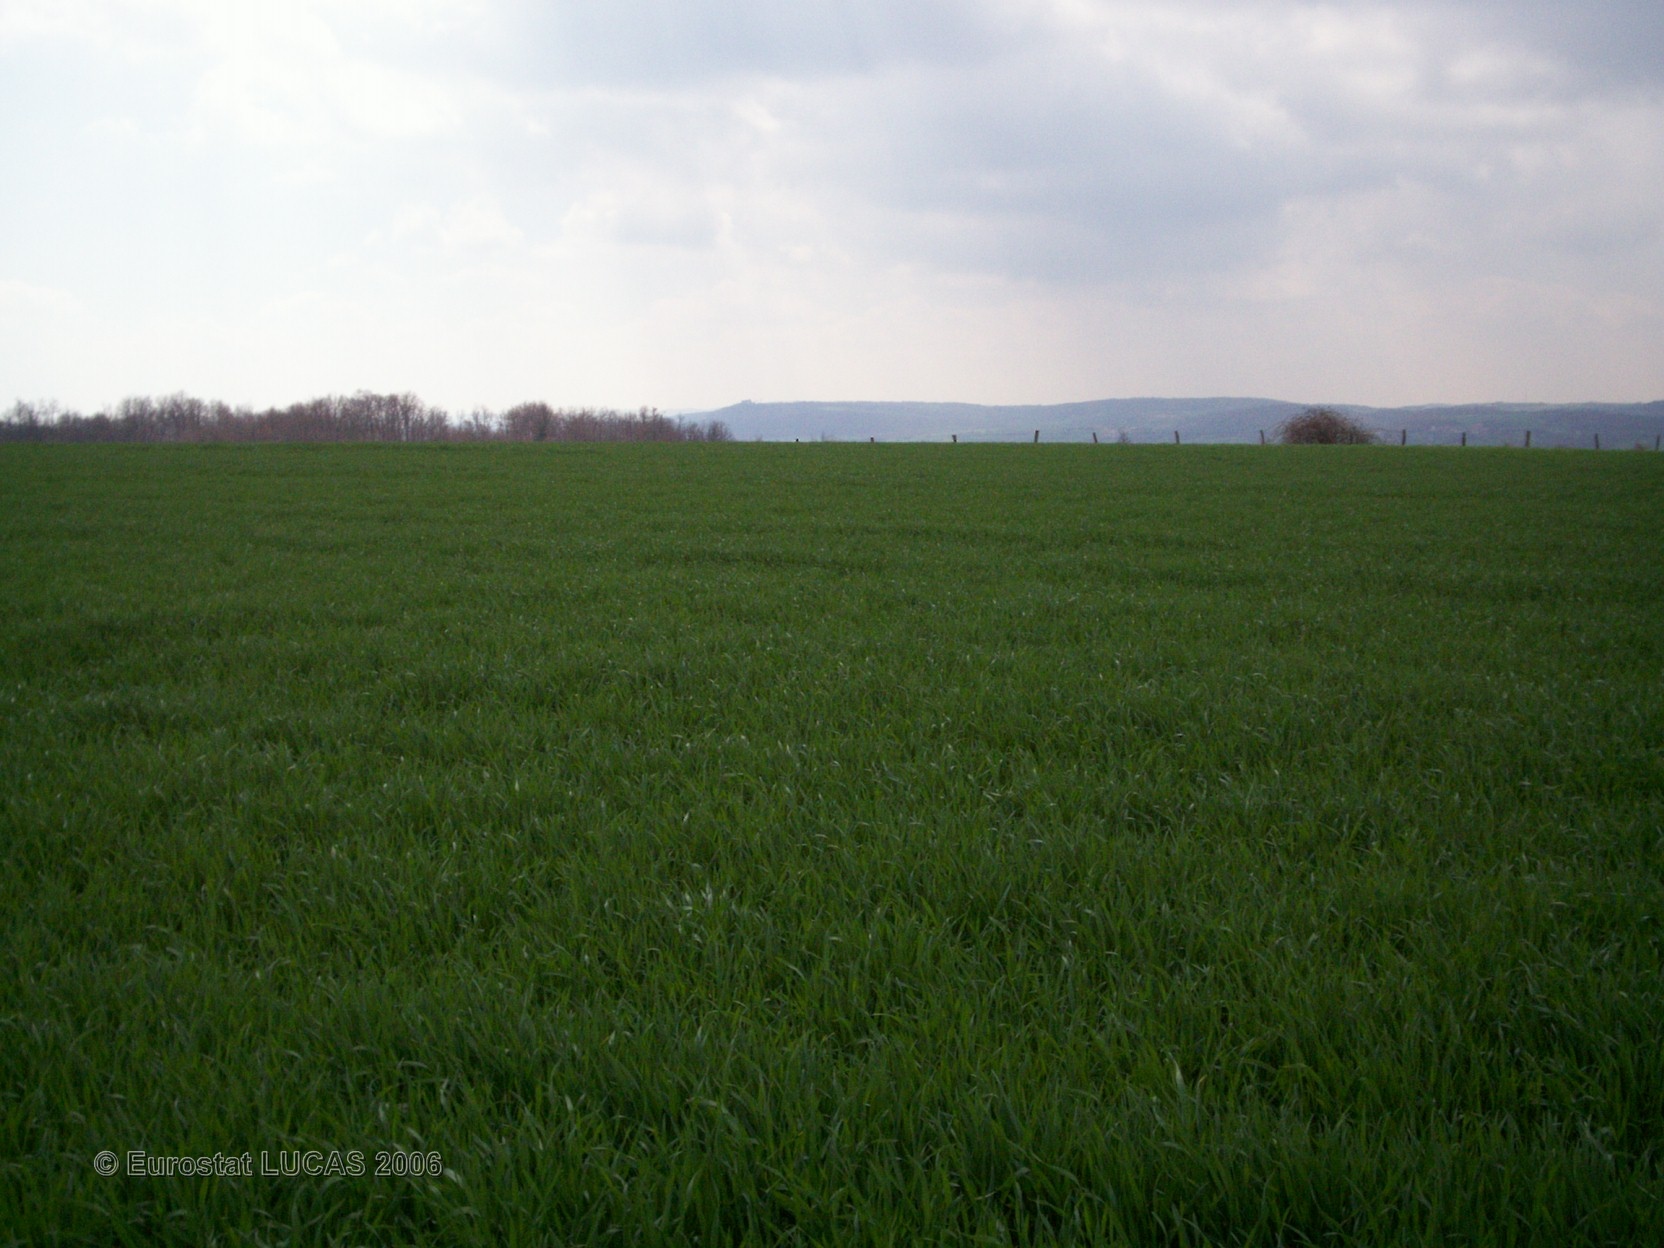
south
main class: Cropland
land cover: Common wheat
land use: Agriculture (excluding fallow land and kitchen gardens)
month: April
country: FR
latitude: 45.3833
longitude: 3.3223
